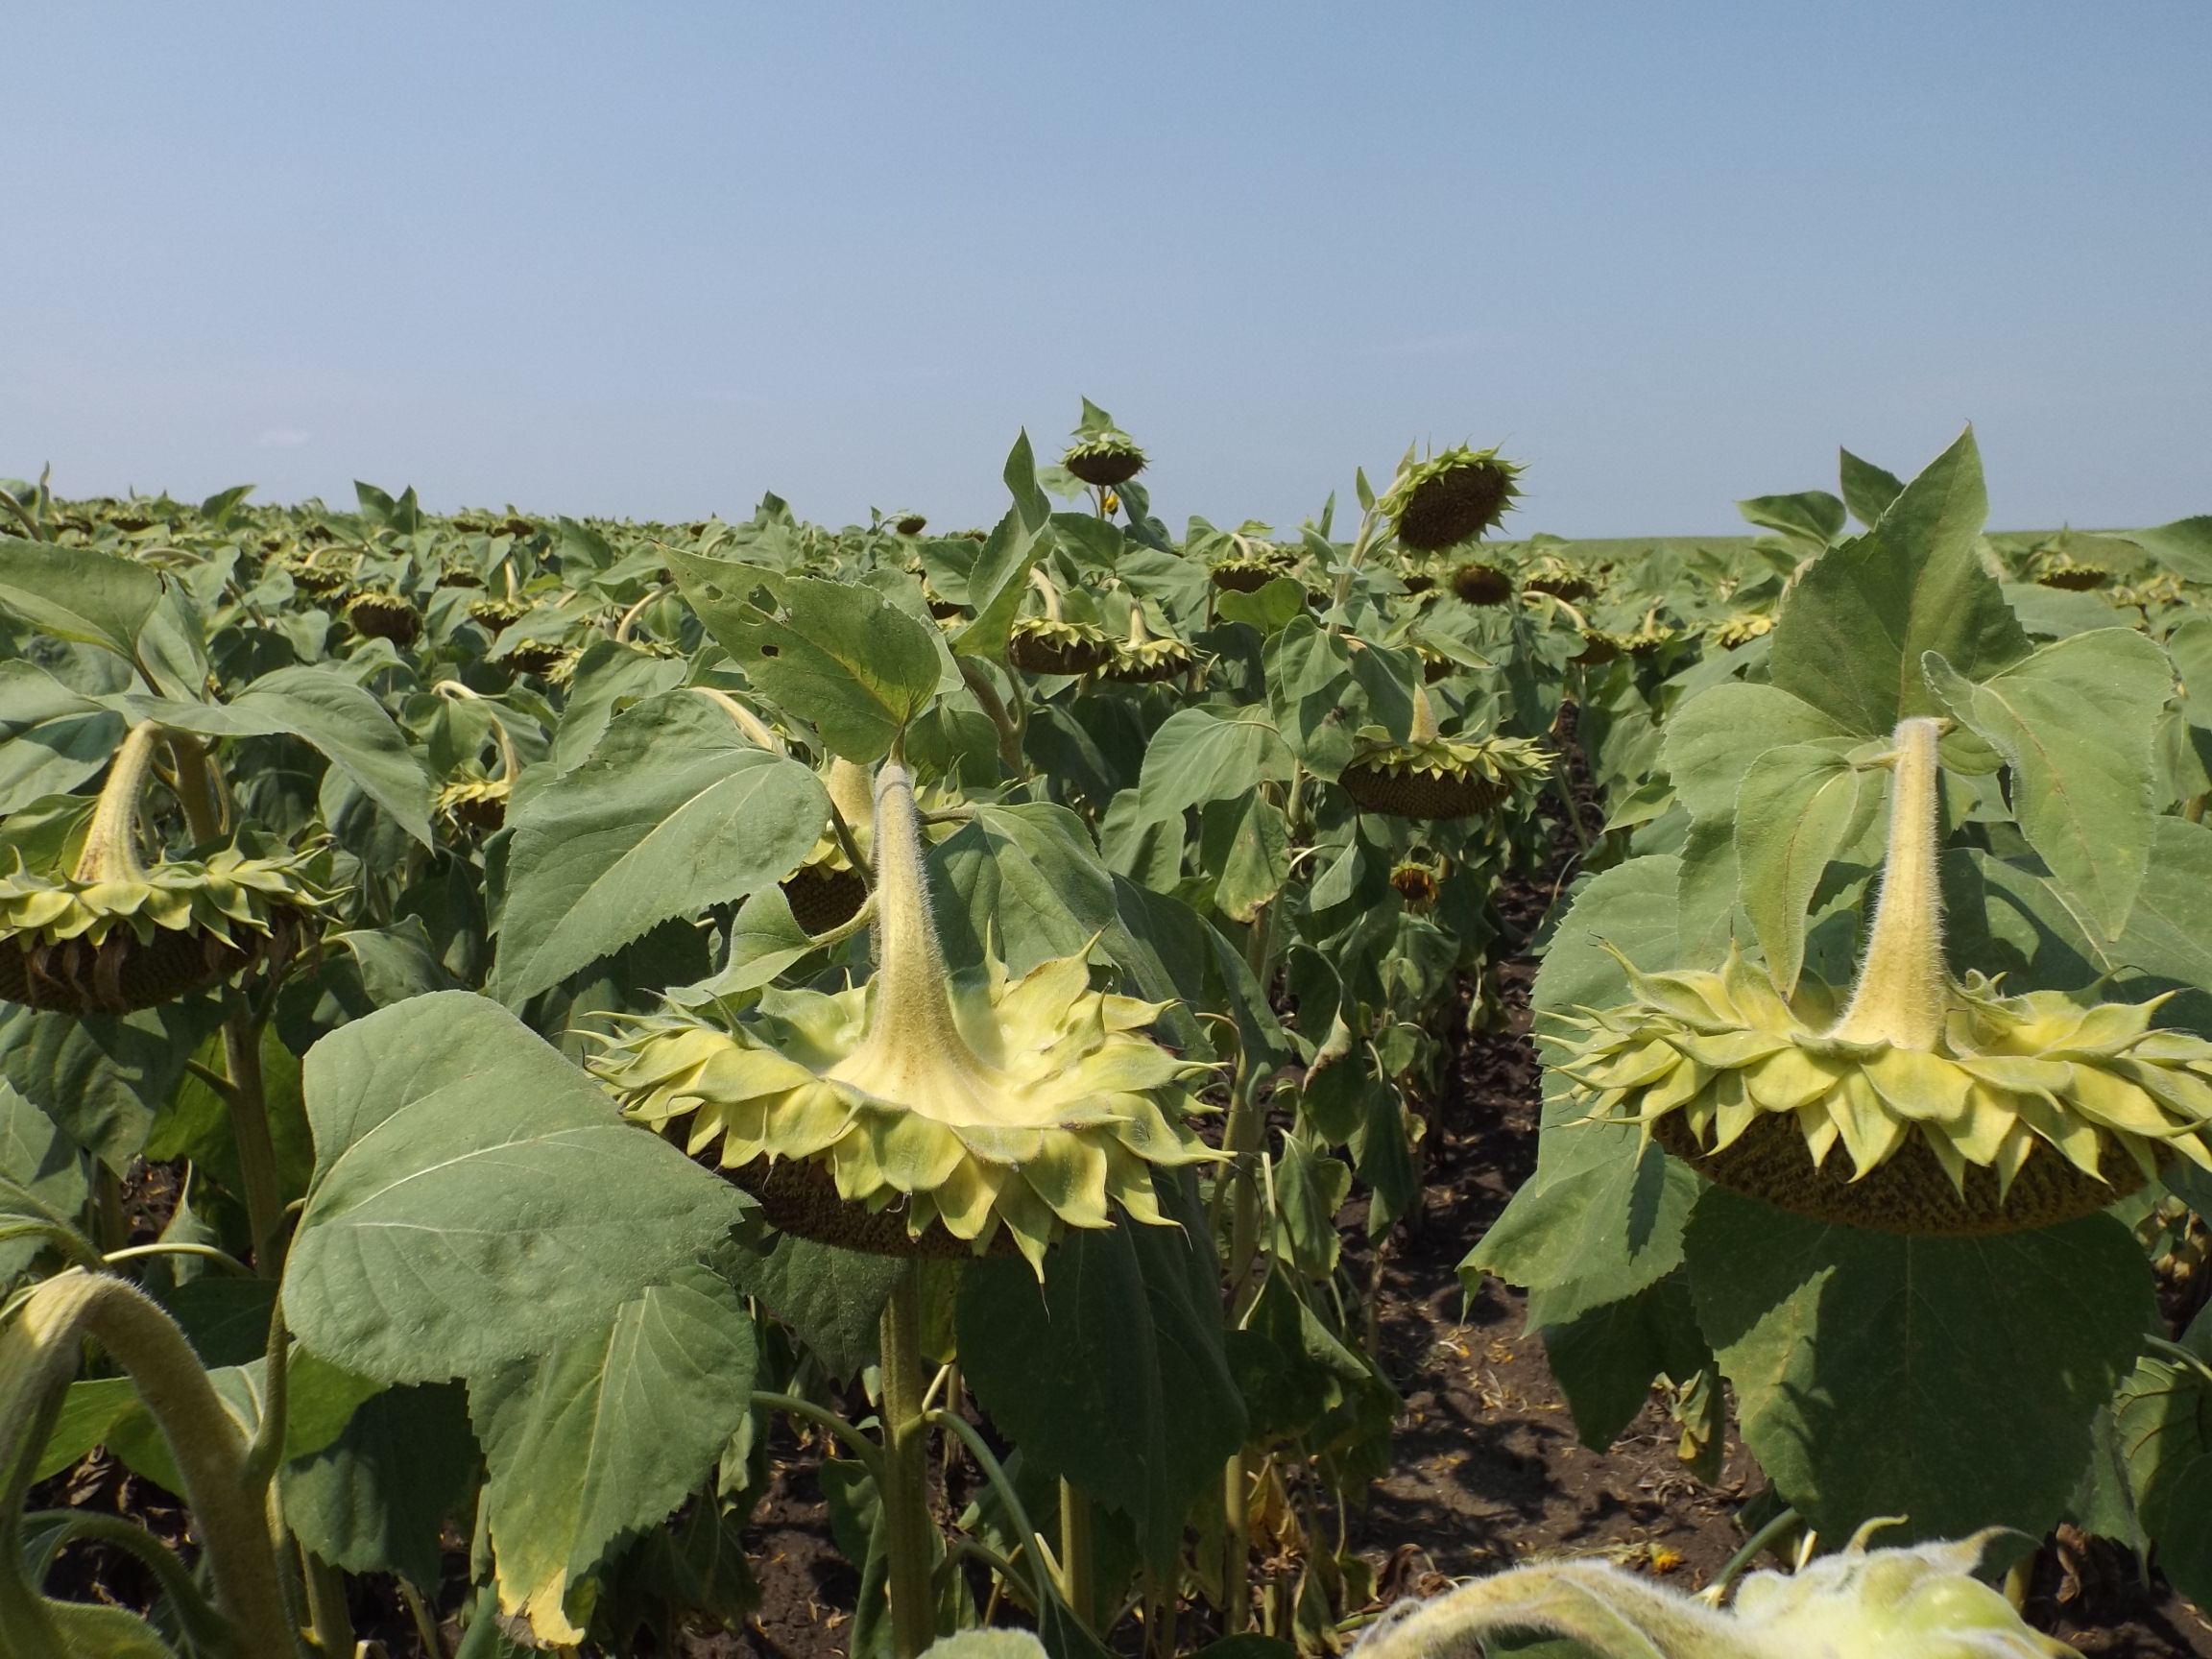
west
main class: Cropland
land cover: Sunflower
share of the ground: > 75 %
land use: Agriculture (excluding fallow land and kitchen gardens)
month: July
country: BG
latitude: 43.4623
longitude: 27.4705
